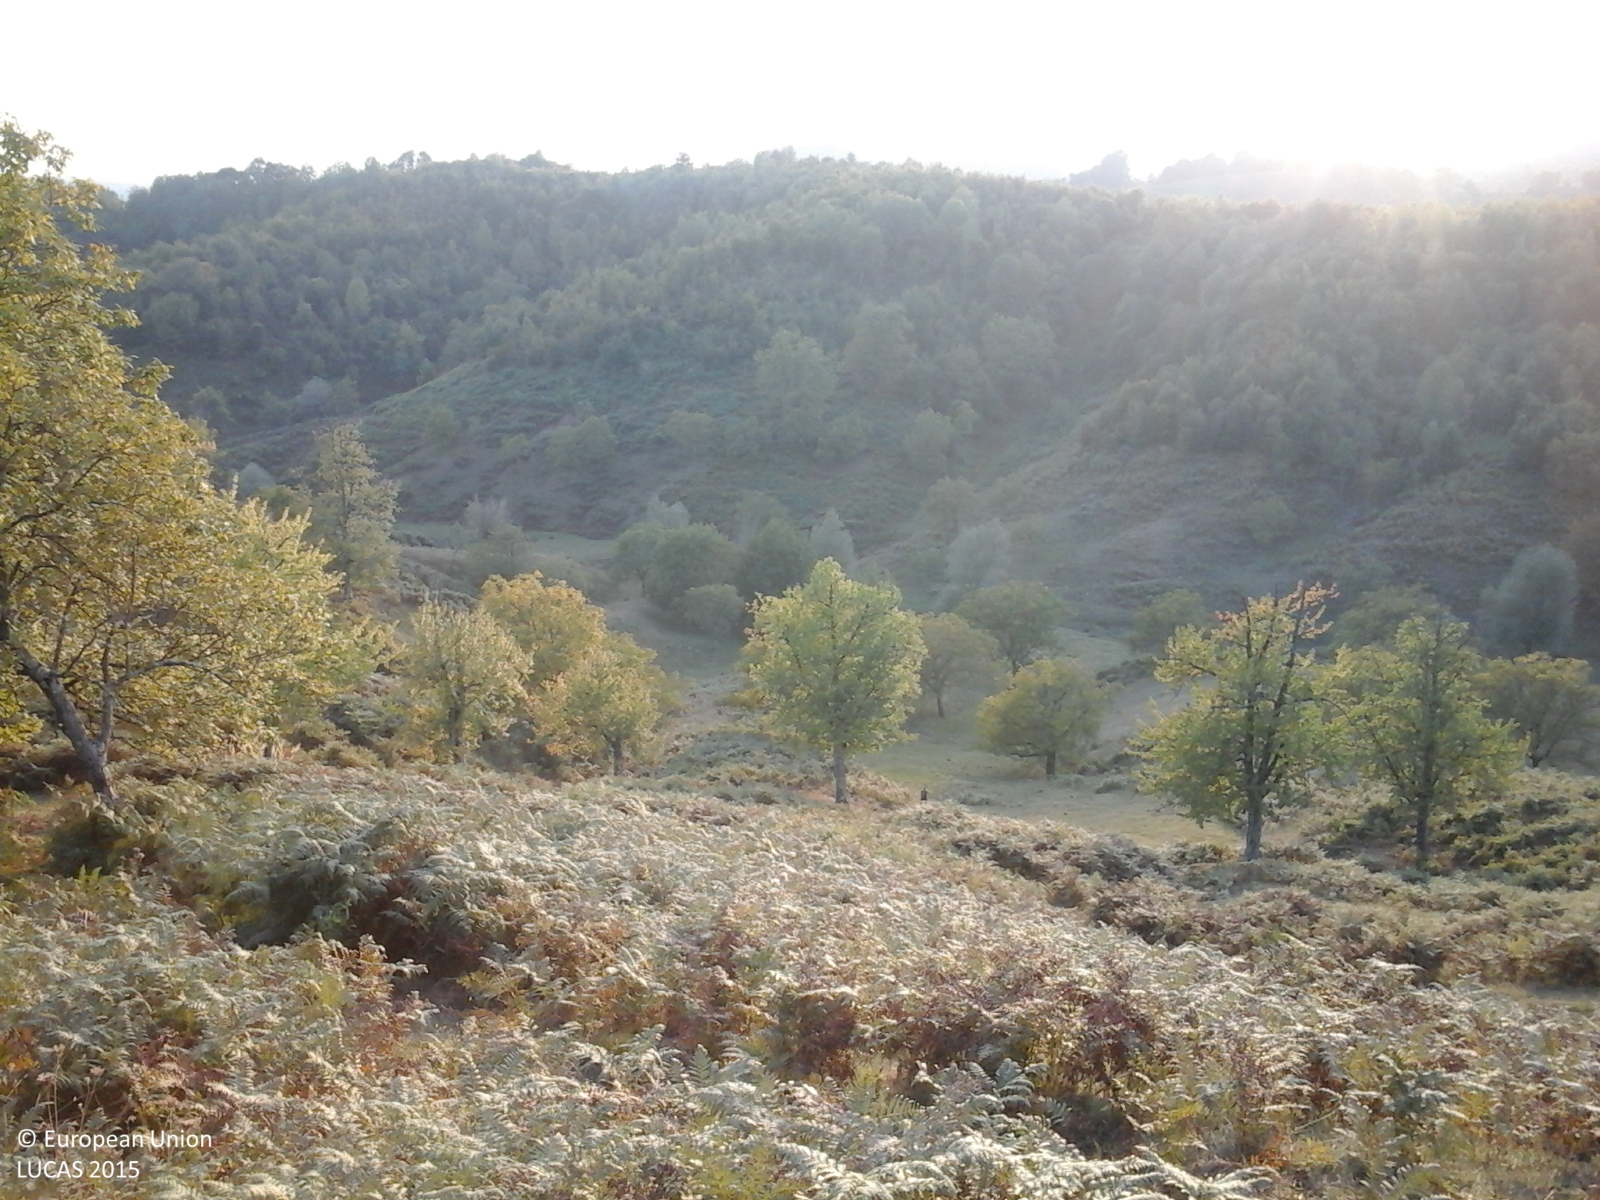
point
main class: Grassland
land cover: Grassland with sparse tree/shrub cover
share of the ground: > 75 %
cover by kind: herbaceous plants 85 %, shrubs 10 %, broadleaved forest trees 5 %
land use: Agriculture (excluding fallow land and kitchen gardens)
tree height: > 5 m
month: September
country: RO
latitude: 46.7530
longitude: 22.4228
